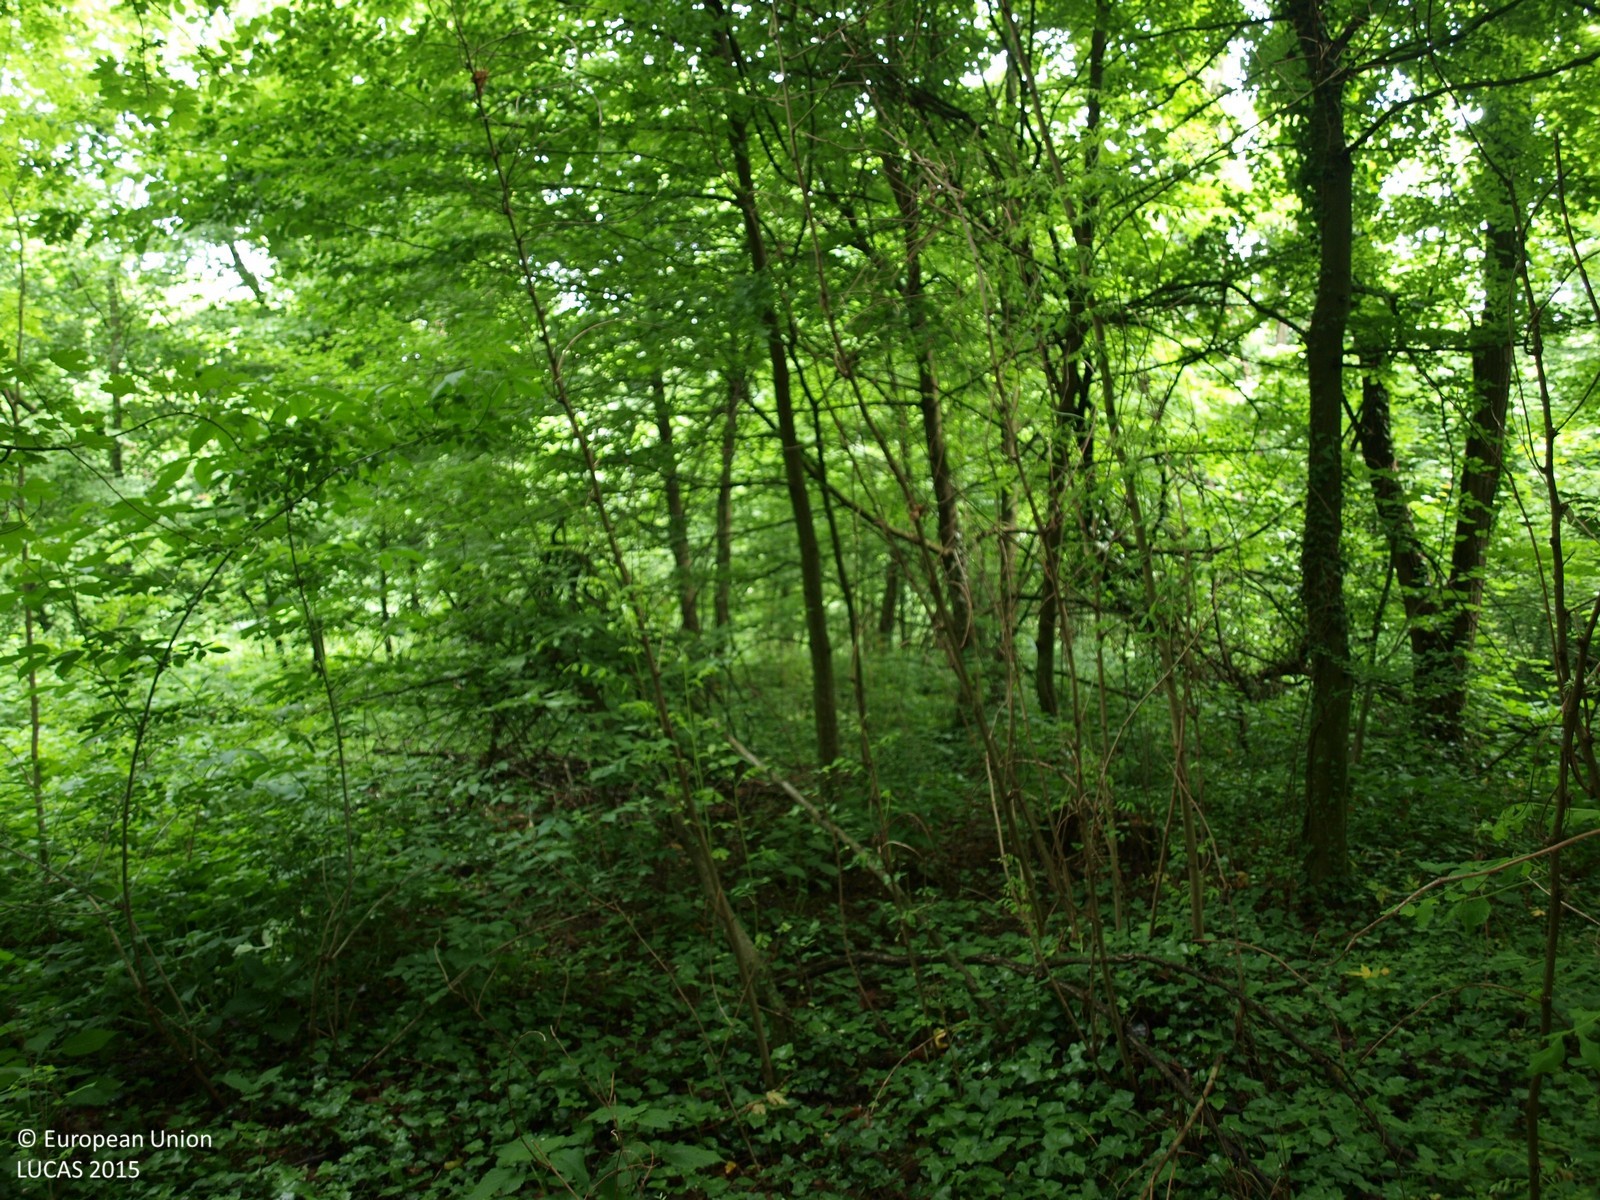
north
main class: Woodland
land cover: Broadleaved woodland
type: mesophytic deciduous forest
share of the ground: > 75 %
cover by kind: broadleaved forest trees 95 %, herbaceous plants 5 %
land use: Forestry
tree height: > 5 m
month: May
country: HR
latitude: 46.0993
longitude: 16.1953
